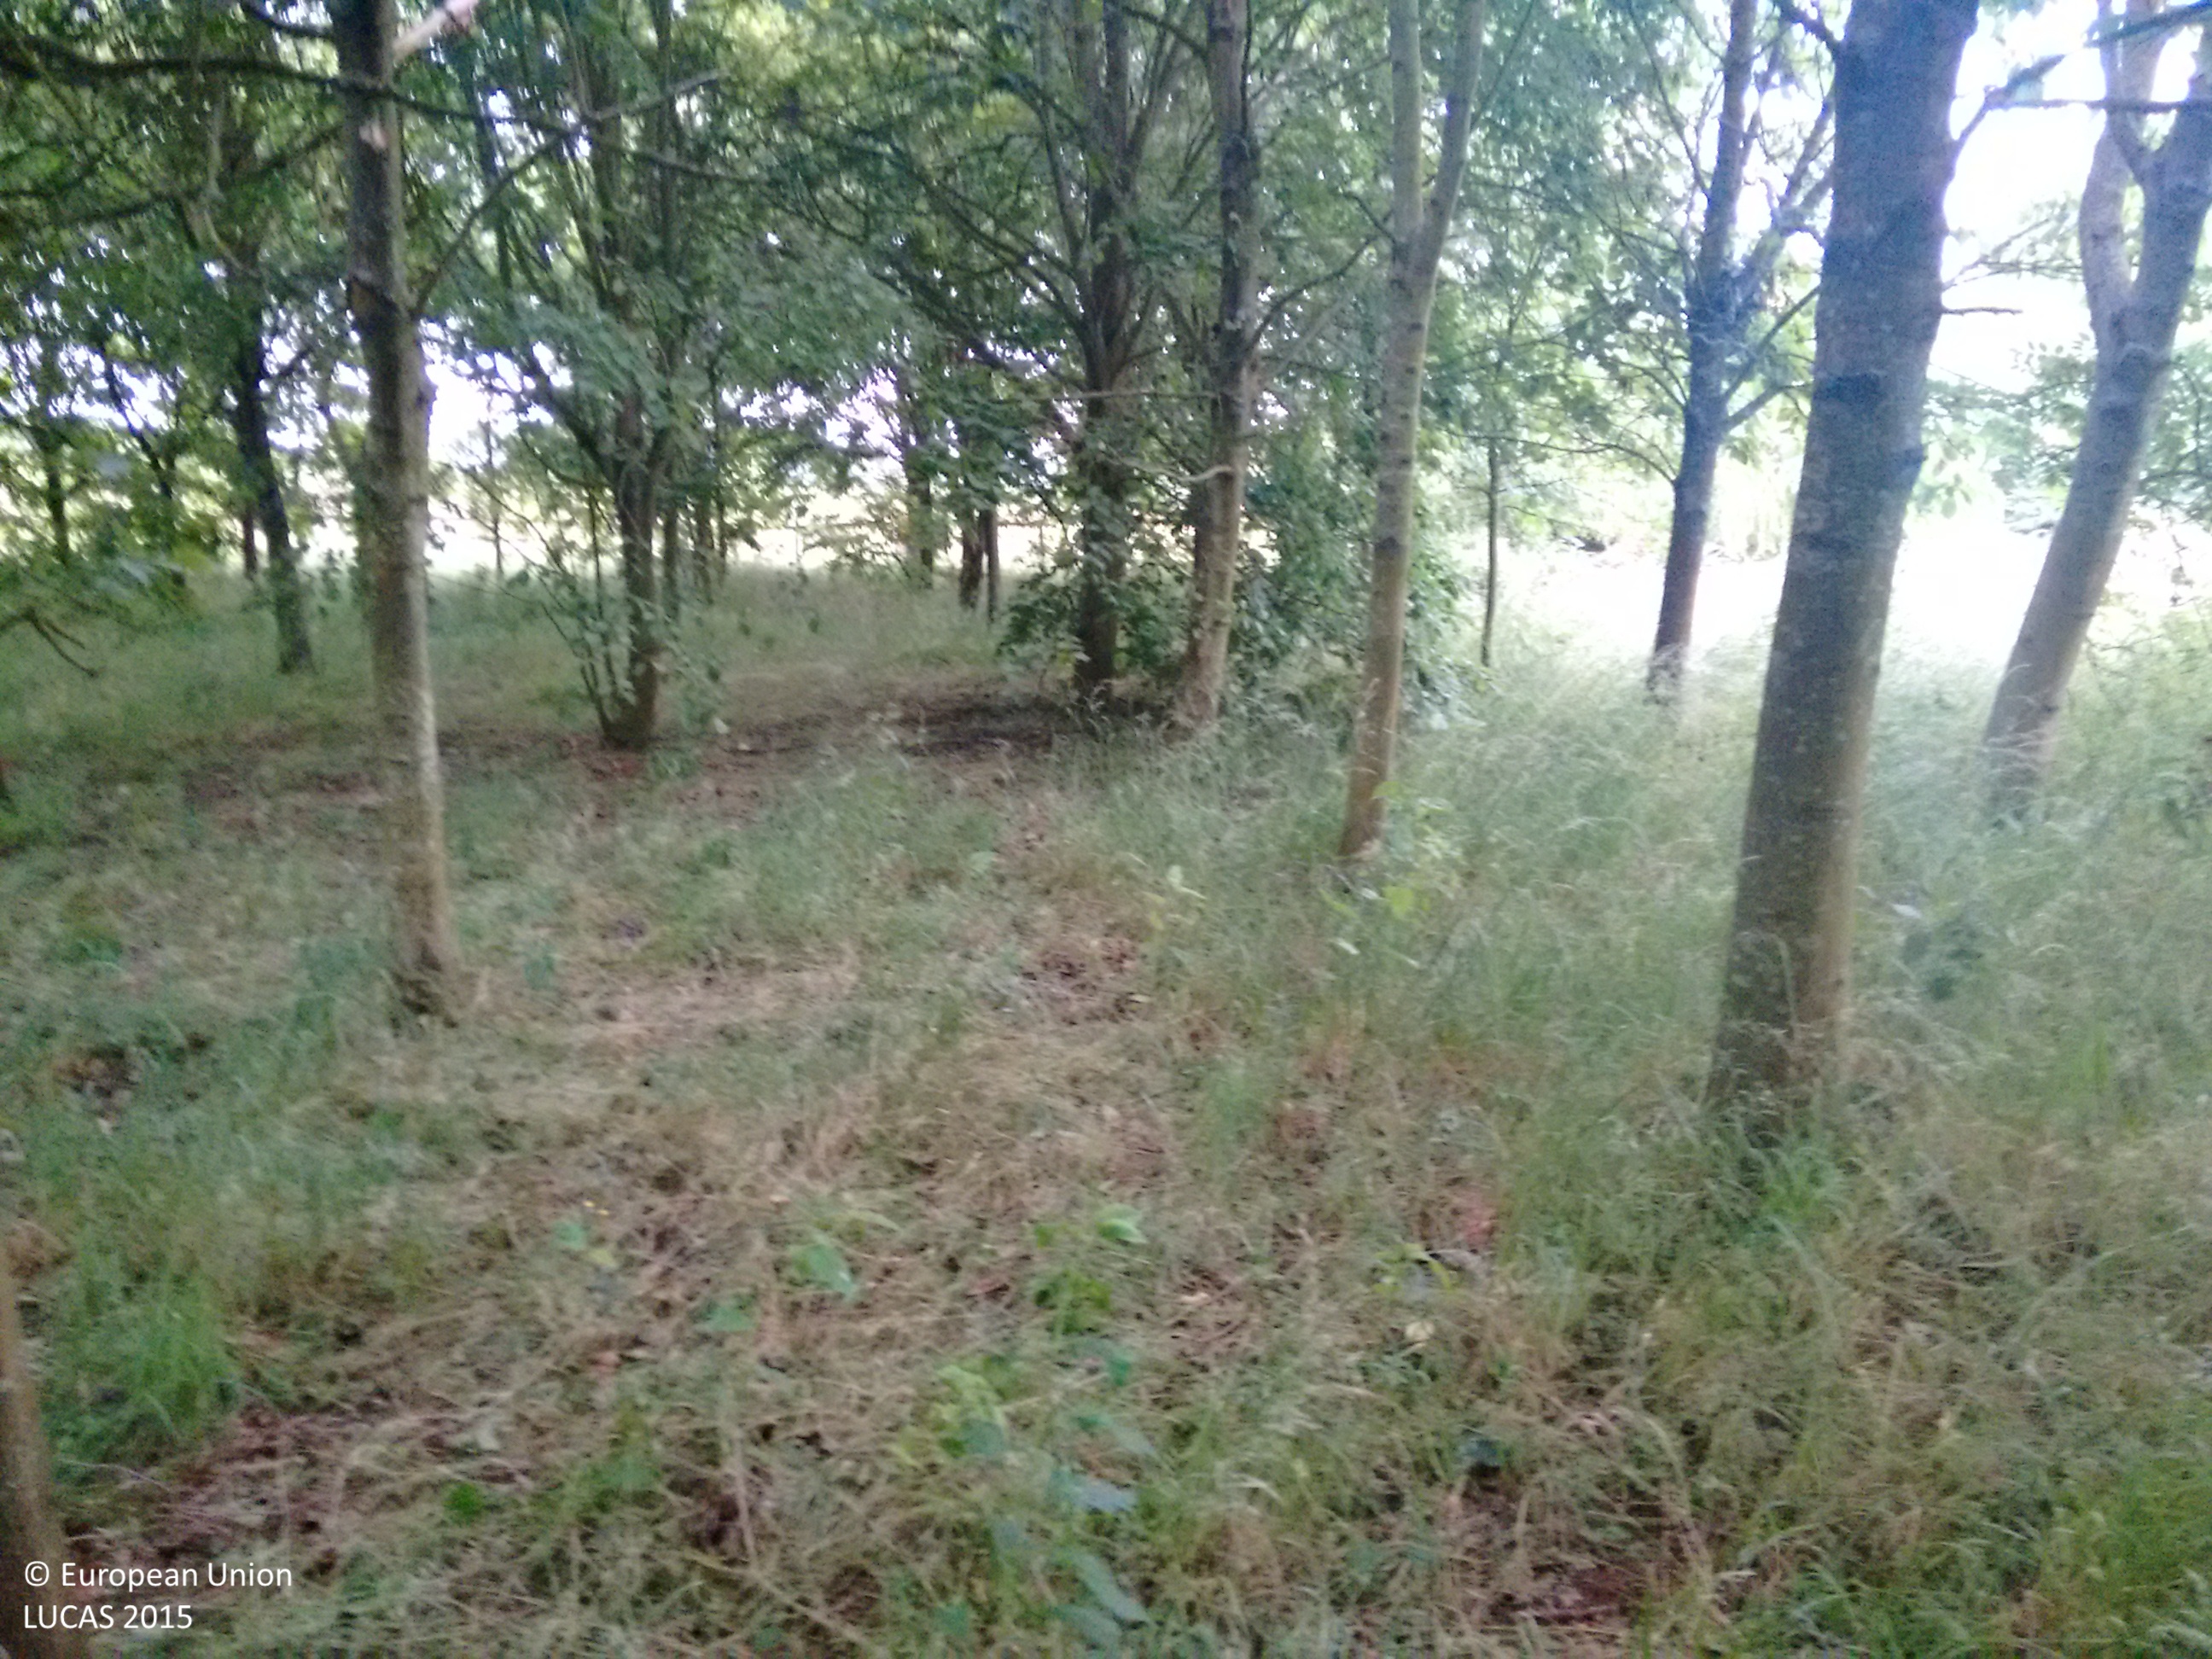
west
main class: Woodland
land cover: Broadleaved woodland
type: mesophytic deciduous forest
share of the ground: > 75 %
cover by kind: broadleaved forest trees 100 %
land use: Forestry
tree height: > 5 m
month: July
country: GB
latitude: 50.9099
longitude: -0.9233
